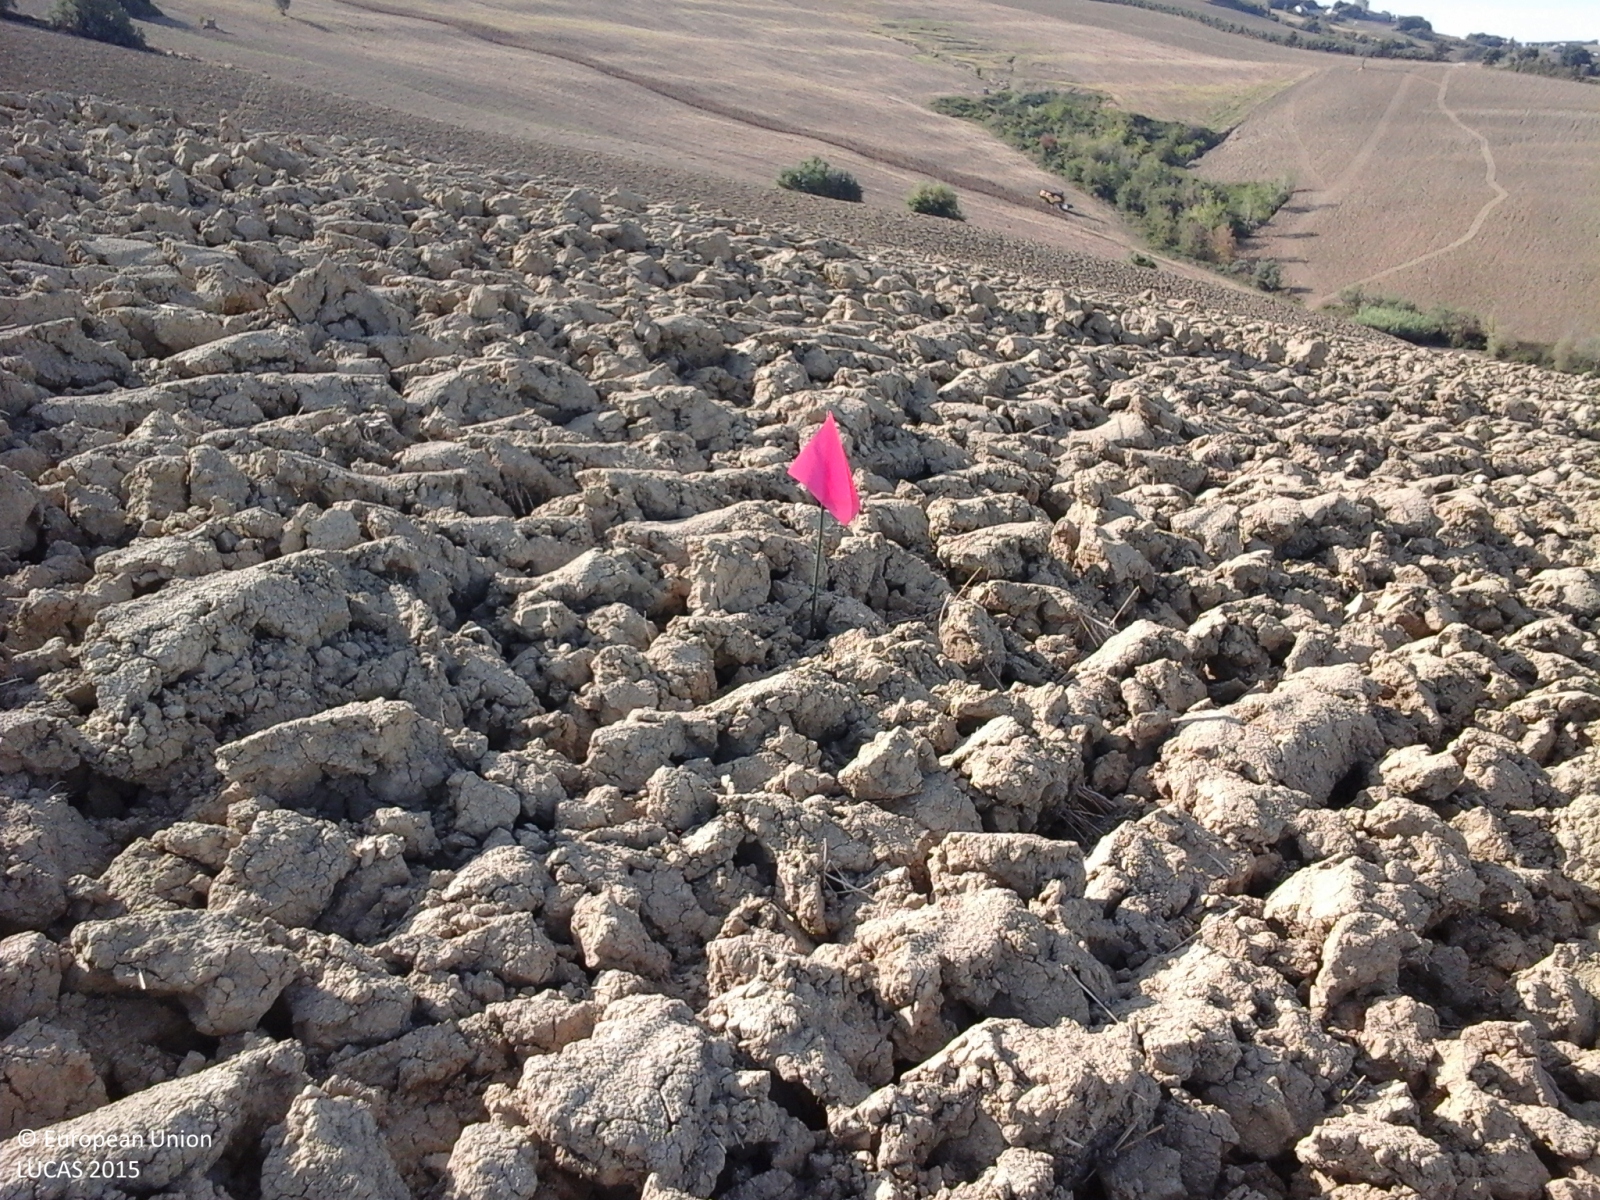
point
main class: Cropland
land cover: Durum wheat
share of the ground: < 10 %
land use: Agriculture (excluding fallow land and kitchen gardens)
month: September
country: IT
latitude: 43.7285
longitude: 13.0343
